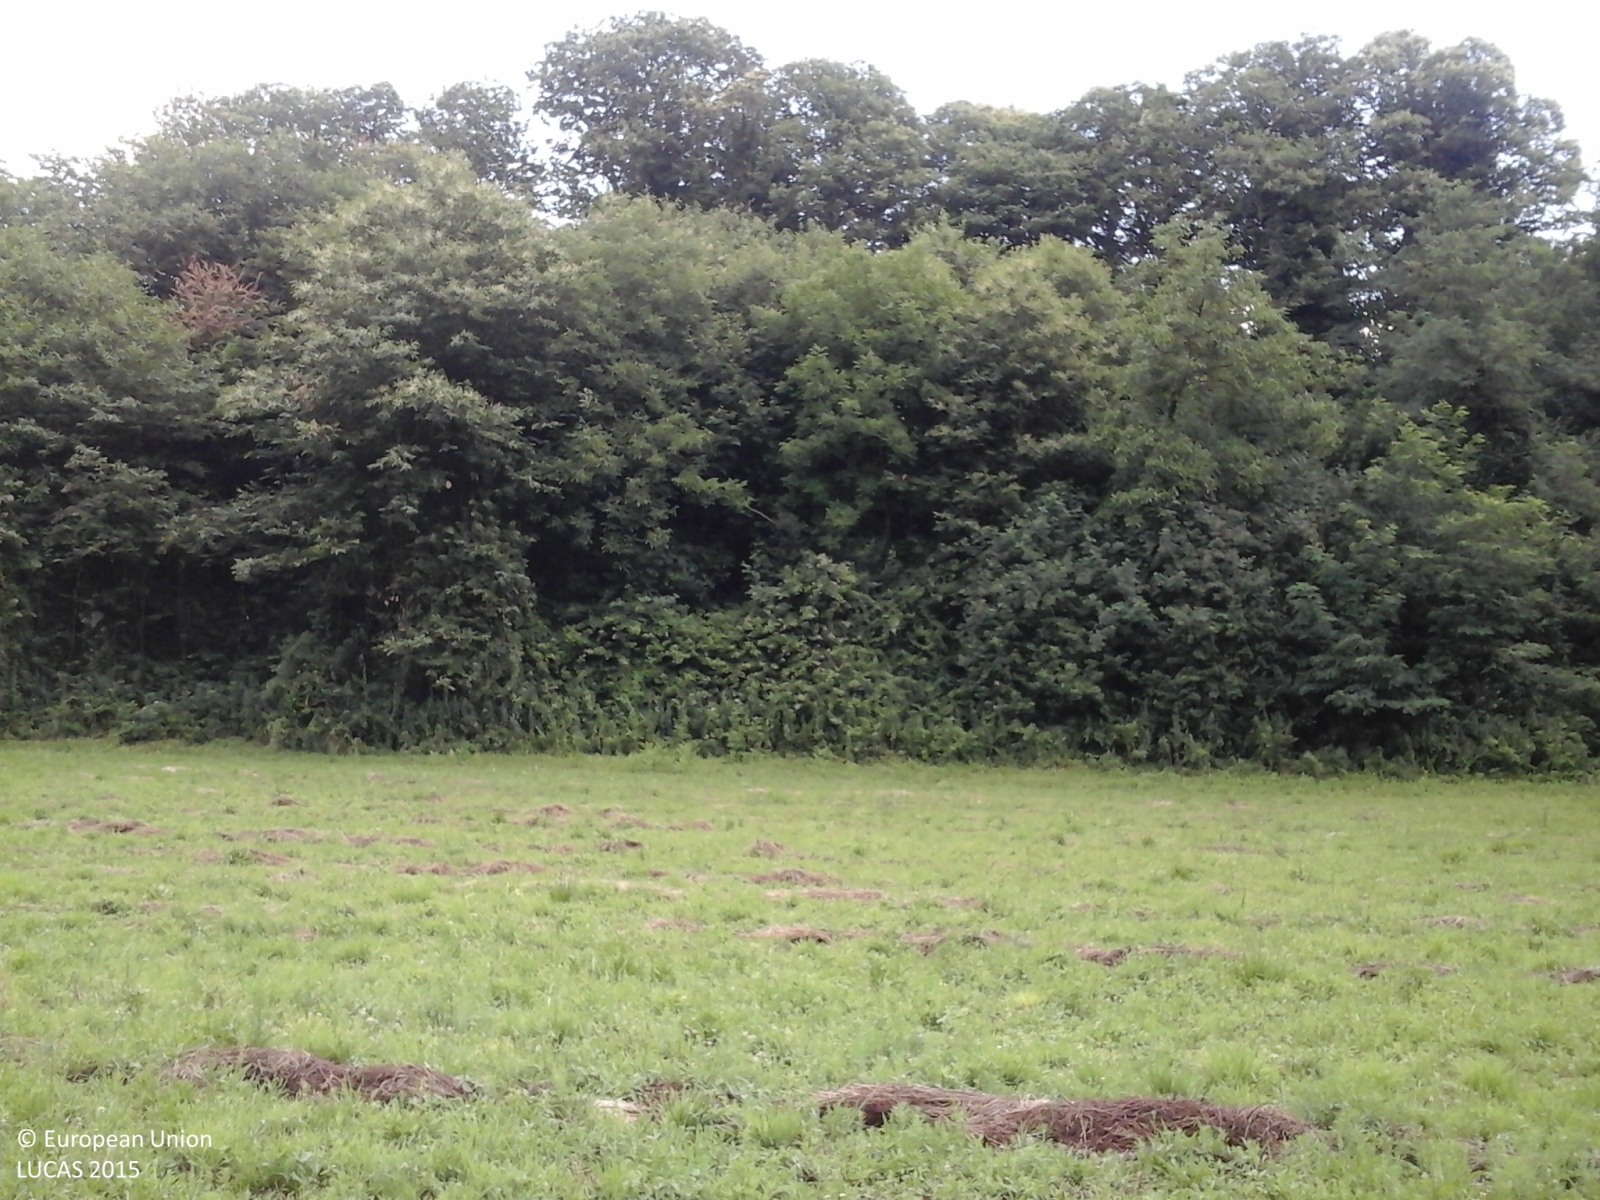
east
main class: Cropland
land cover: Temporary grasslands
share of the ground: > 75 %
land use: Agriculture (excluding fallow land and kitchen gardens)
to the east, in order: Temporary grasslands; Broadleaved woodland; Abandoned hedges; Grassland with sparse tree/shrub cover; Artificial constructions; Grassland with sparse tree/shrub cover; Artificial constructions in urban areas; Single bushes/trees; Grassland with sparse tree/shrub cover; Artificial constructions in urban areas; Grassland with sparse tree/shrub cover; Fences; Managed hedges; Grassland with sparse tree/shrub cover; Fences; Grassland without tree/shrub cover; Paved roads, cycling and walking lanes; Grass margins
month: June
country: IT
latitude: 41.8167
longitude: 12.9145
